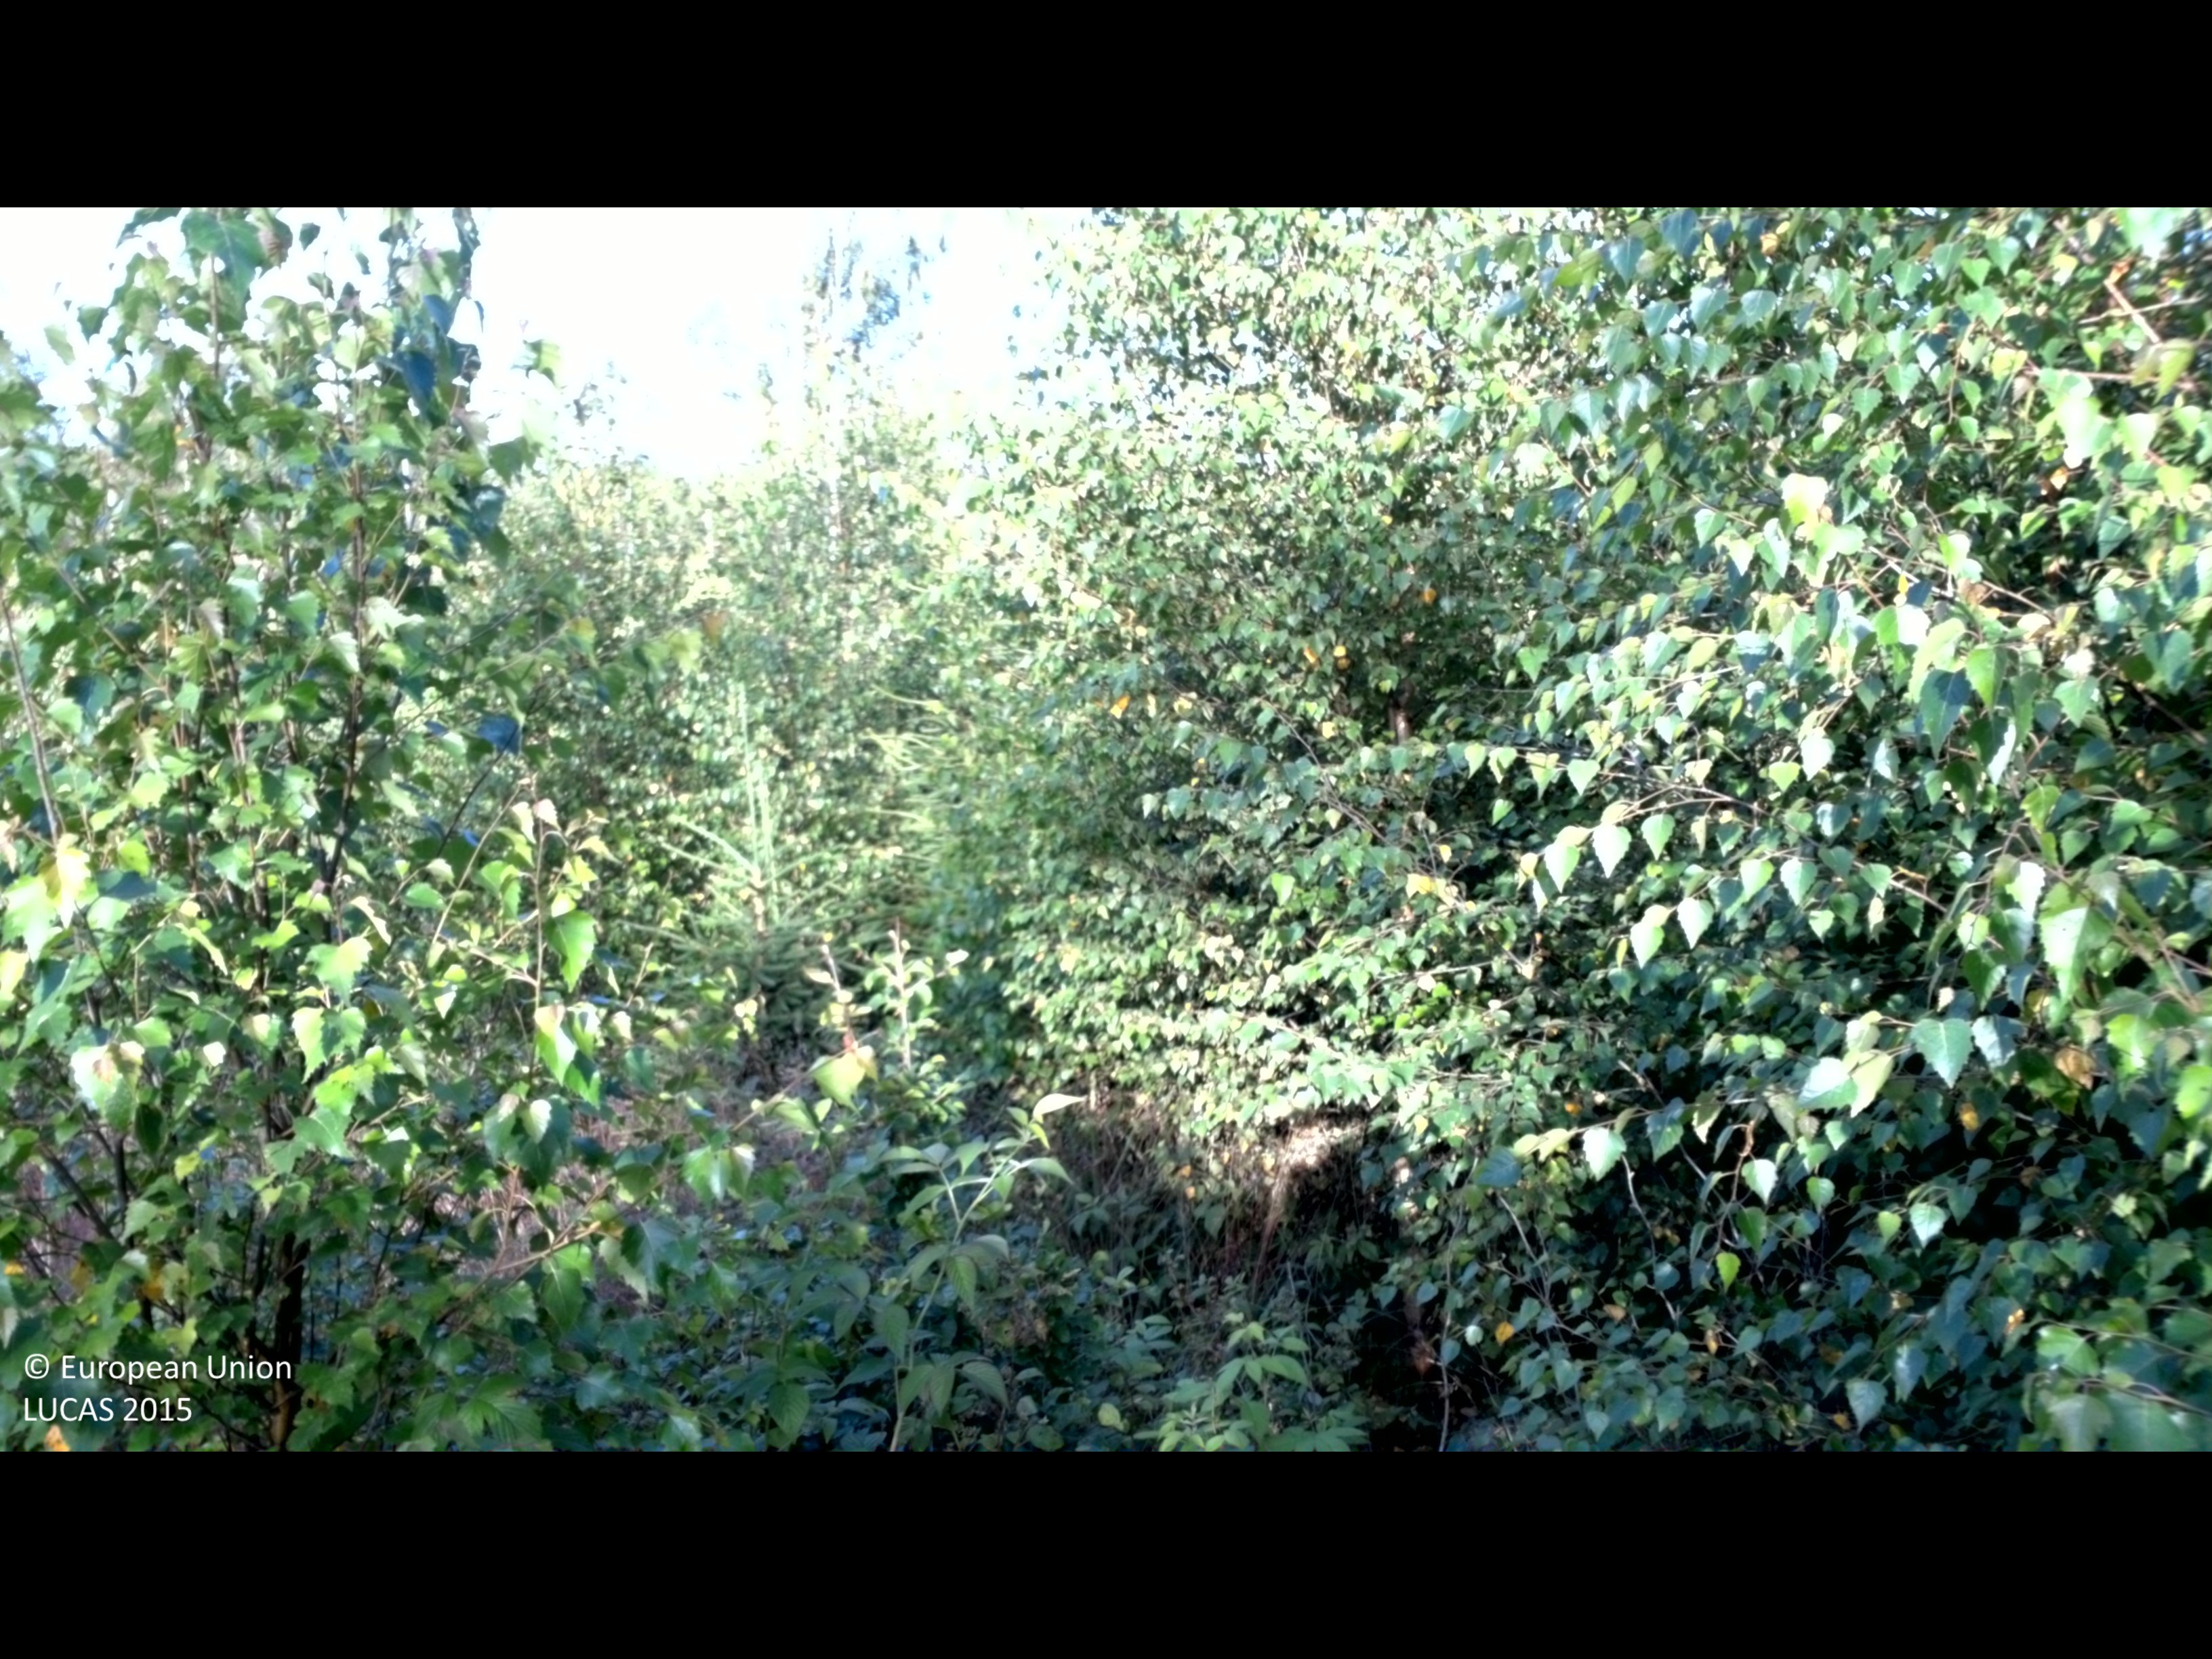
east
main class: Woodland
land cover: Broadleaved woodland
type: boreal forest
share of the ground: 50 - 75 %
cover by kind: broadleaved forest trees 65 %, herbaceous plants 20 %, shrubs 10 %, coniferous forest trees 5 %
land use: Forestry
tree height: < 5 m
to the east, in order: Broadleaved woodland; Grassland with sparse tree/shrub cover; Single bushes/trees; Grassland with sparse tree/shrub cover; Shrubland without tree cover; Spruce dominated coniferous woodland
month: August
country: SE
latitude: 56.3807
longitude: 14.4511
